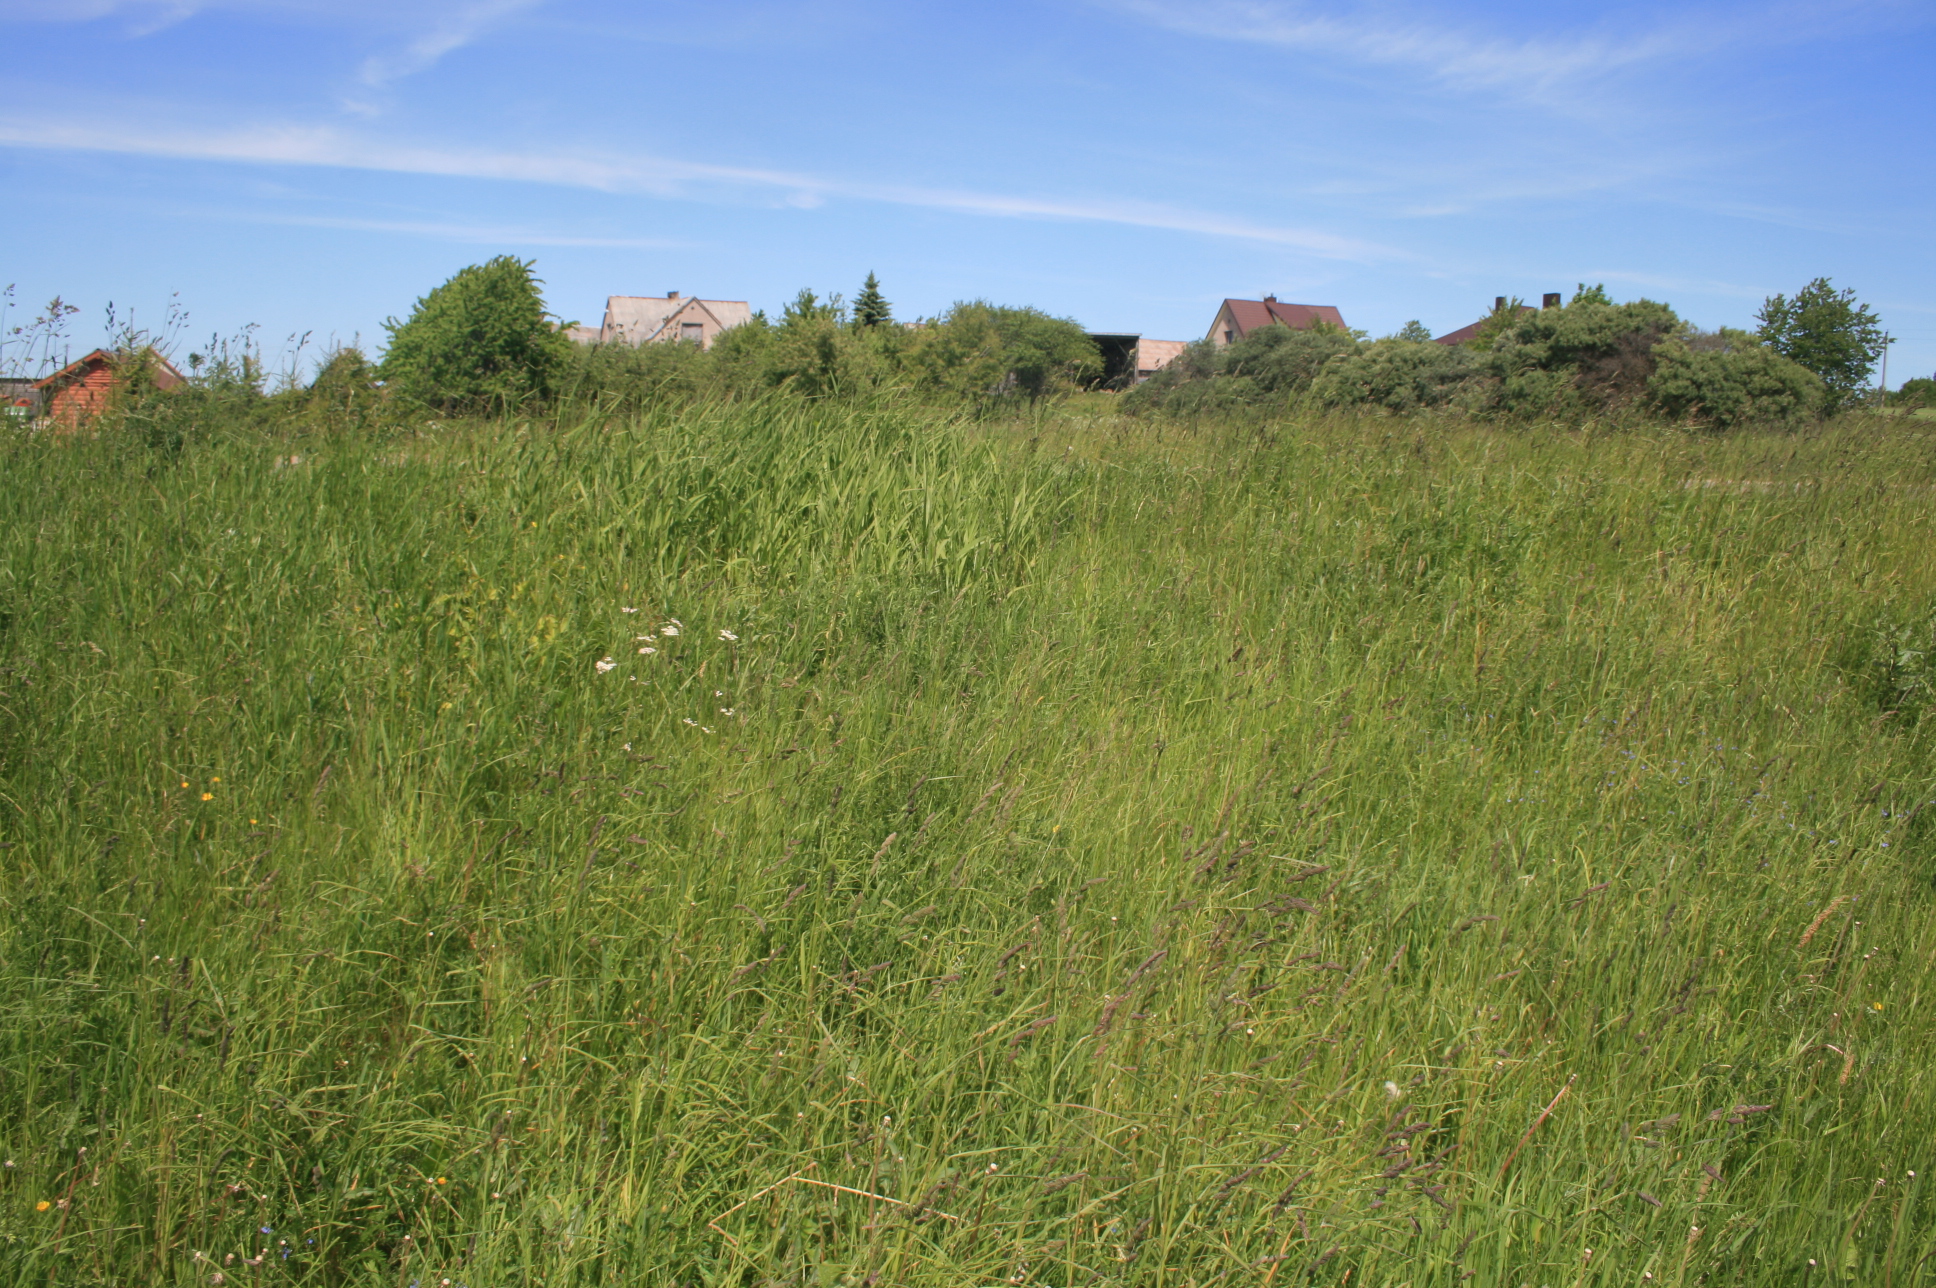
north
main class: Grassland
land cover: Grassland without tree/shrub cover
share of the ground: > 75 %
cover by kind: herbaceous plants 100 %
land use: Agriculture (excluding fallow land and kitchen gardens)
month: June
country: LT
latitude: 55.9358
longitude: 22.3351
